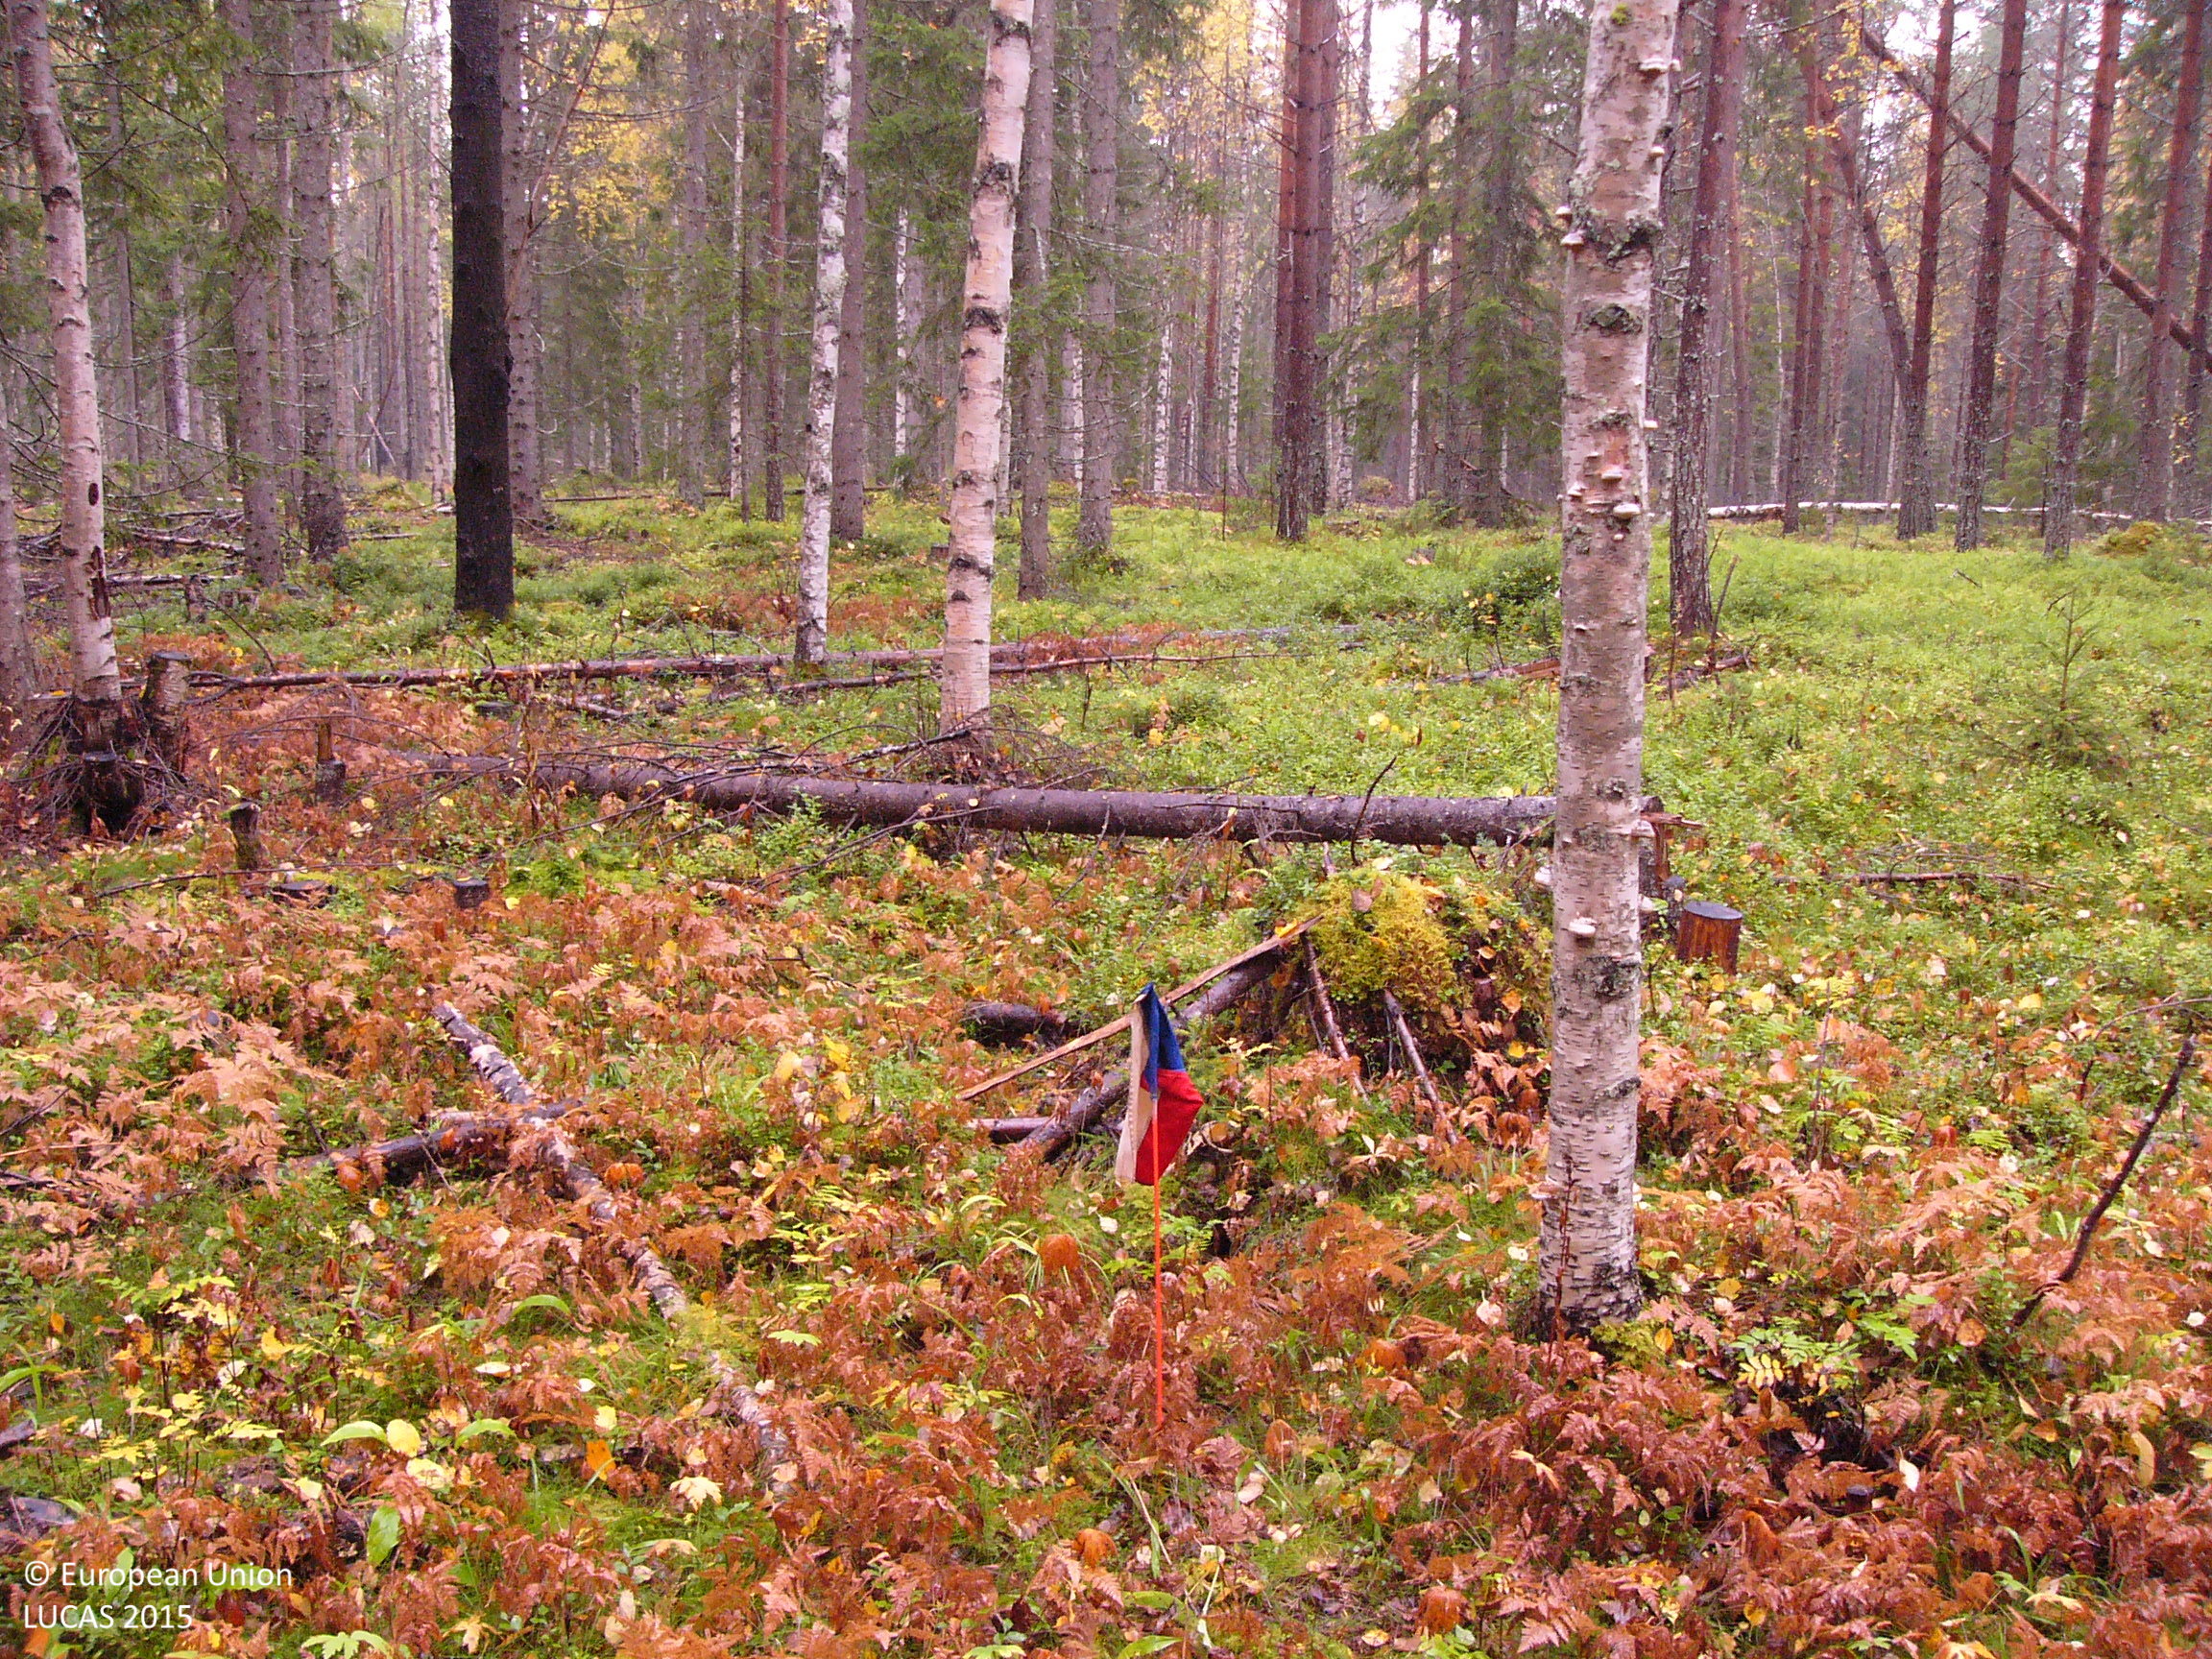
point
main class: Woodland
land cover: Spruce dominated mixed woodland
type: boreal forest
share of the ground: 50 - 75 %
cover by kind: coniferous forest trees 45 %, shrubs 20 %, broadleaved forest trees 15 %, lichens and mosses 15 %, herbaceous plants 5 %
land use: Forestry
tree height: > 5 m
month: September
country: SE
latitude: 64.7867
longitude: 18.8664
